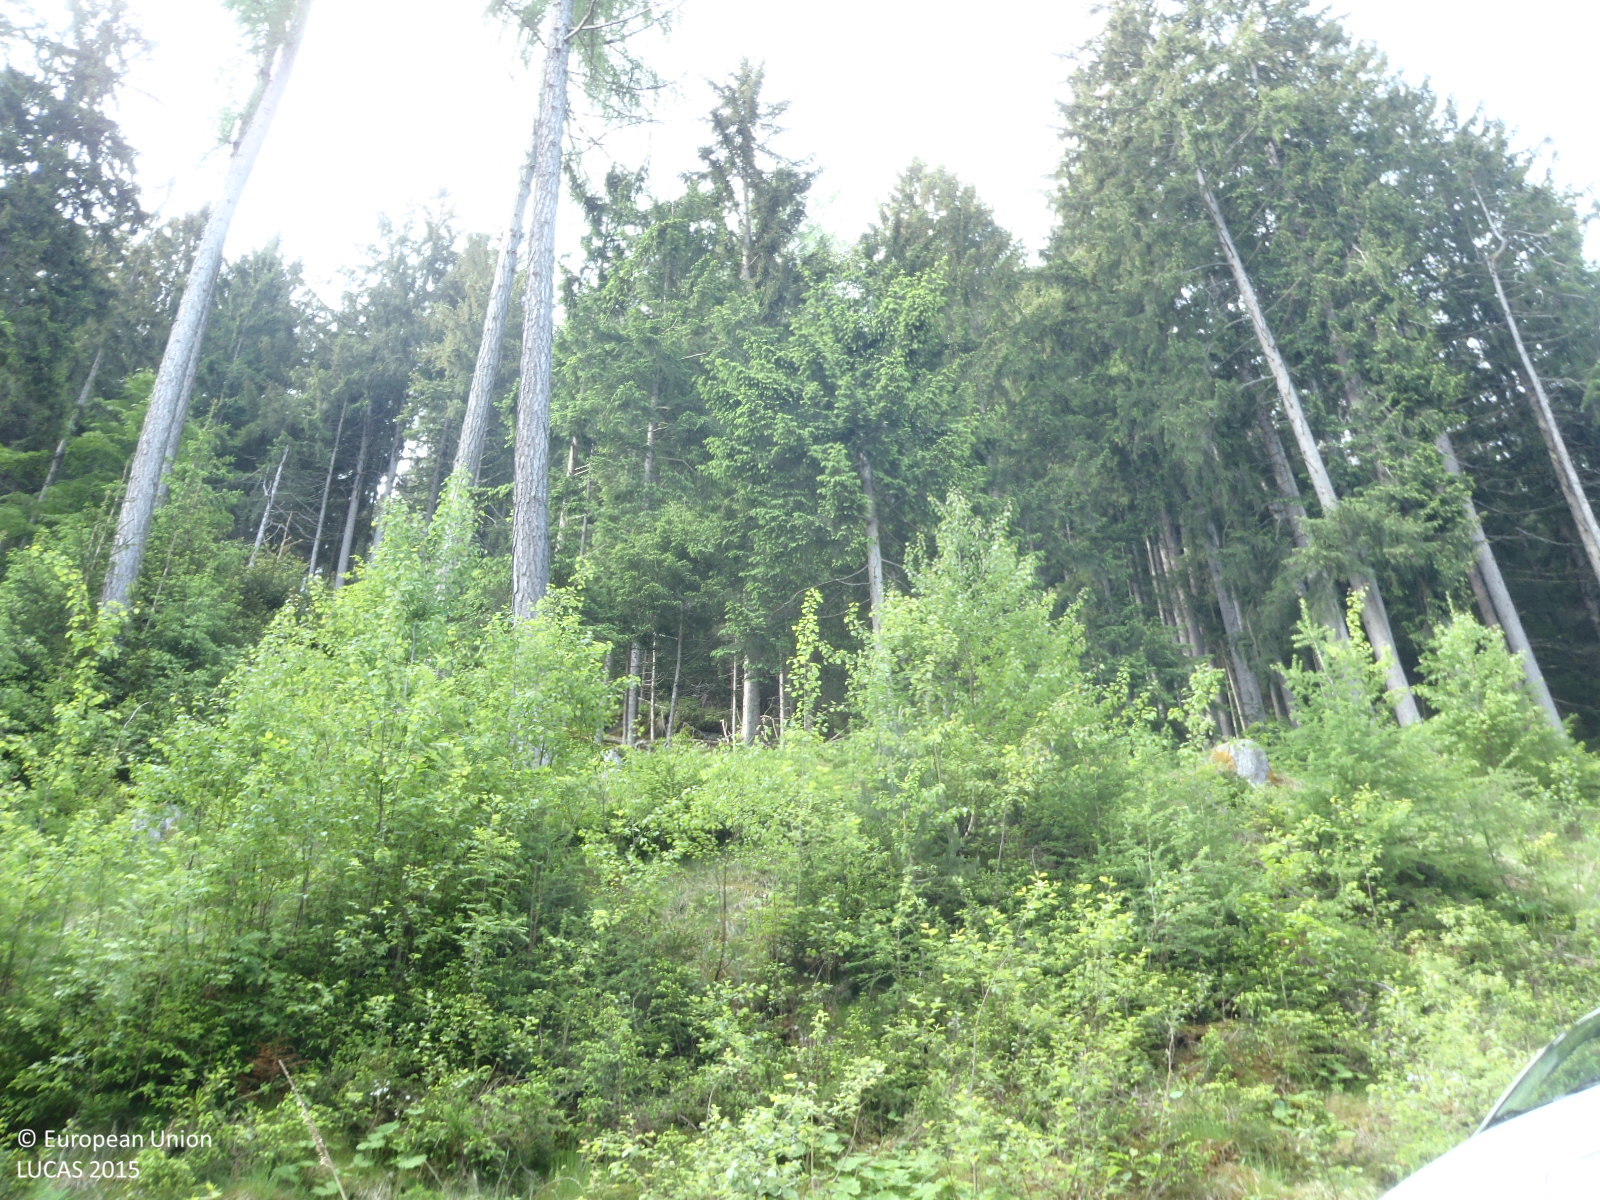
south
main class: Woodland
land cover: Spruce dominated mixed woodland
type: alpine coniferous forest
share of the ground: > 75 %
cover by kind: coniferous forest trees 65 %, broadleaved forest trees 25 %, shrubs 10 %
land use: Forestry
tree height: > 5 m
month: May
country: AT
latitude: 47.2632
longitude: 11.1751
